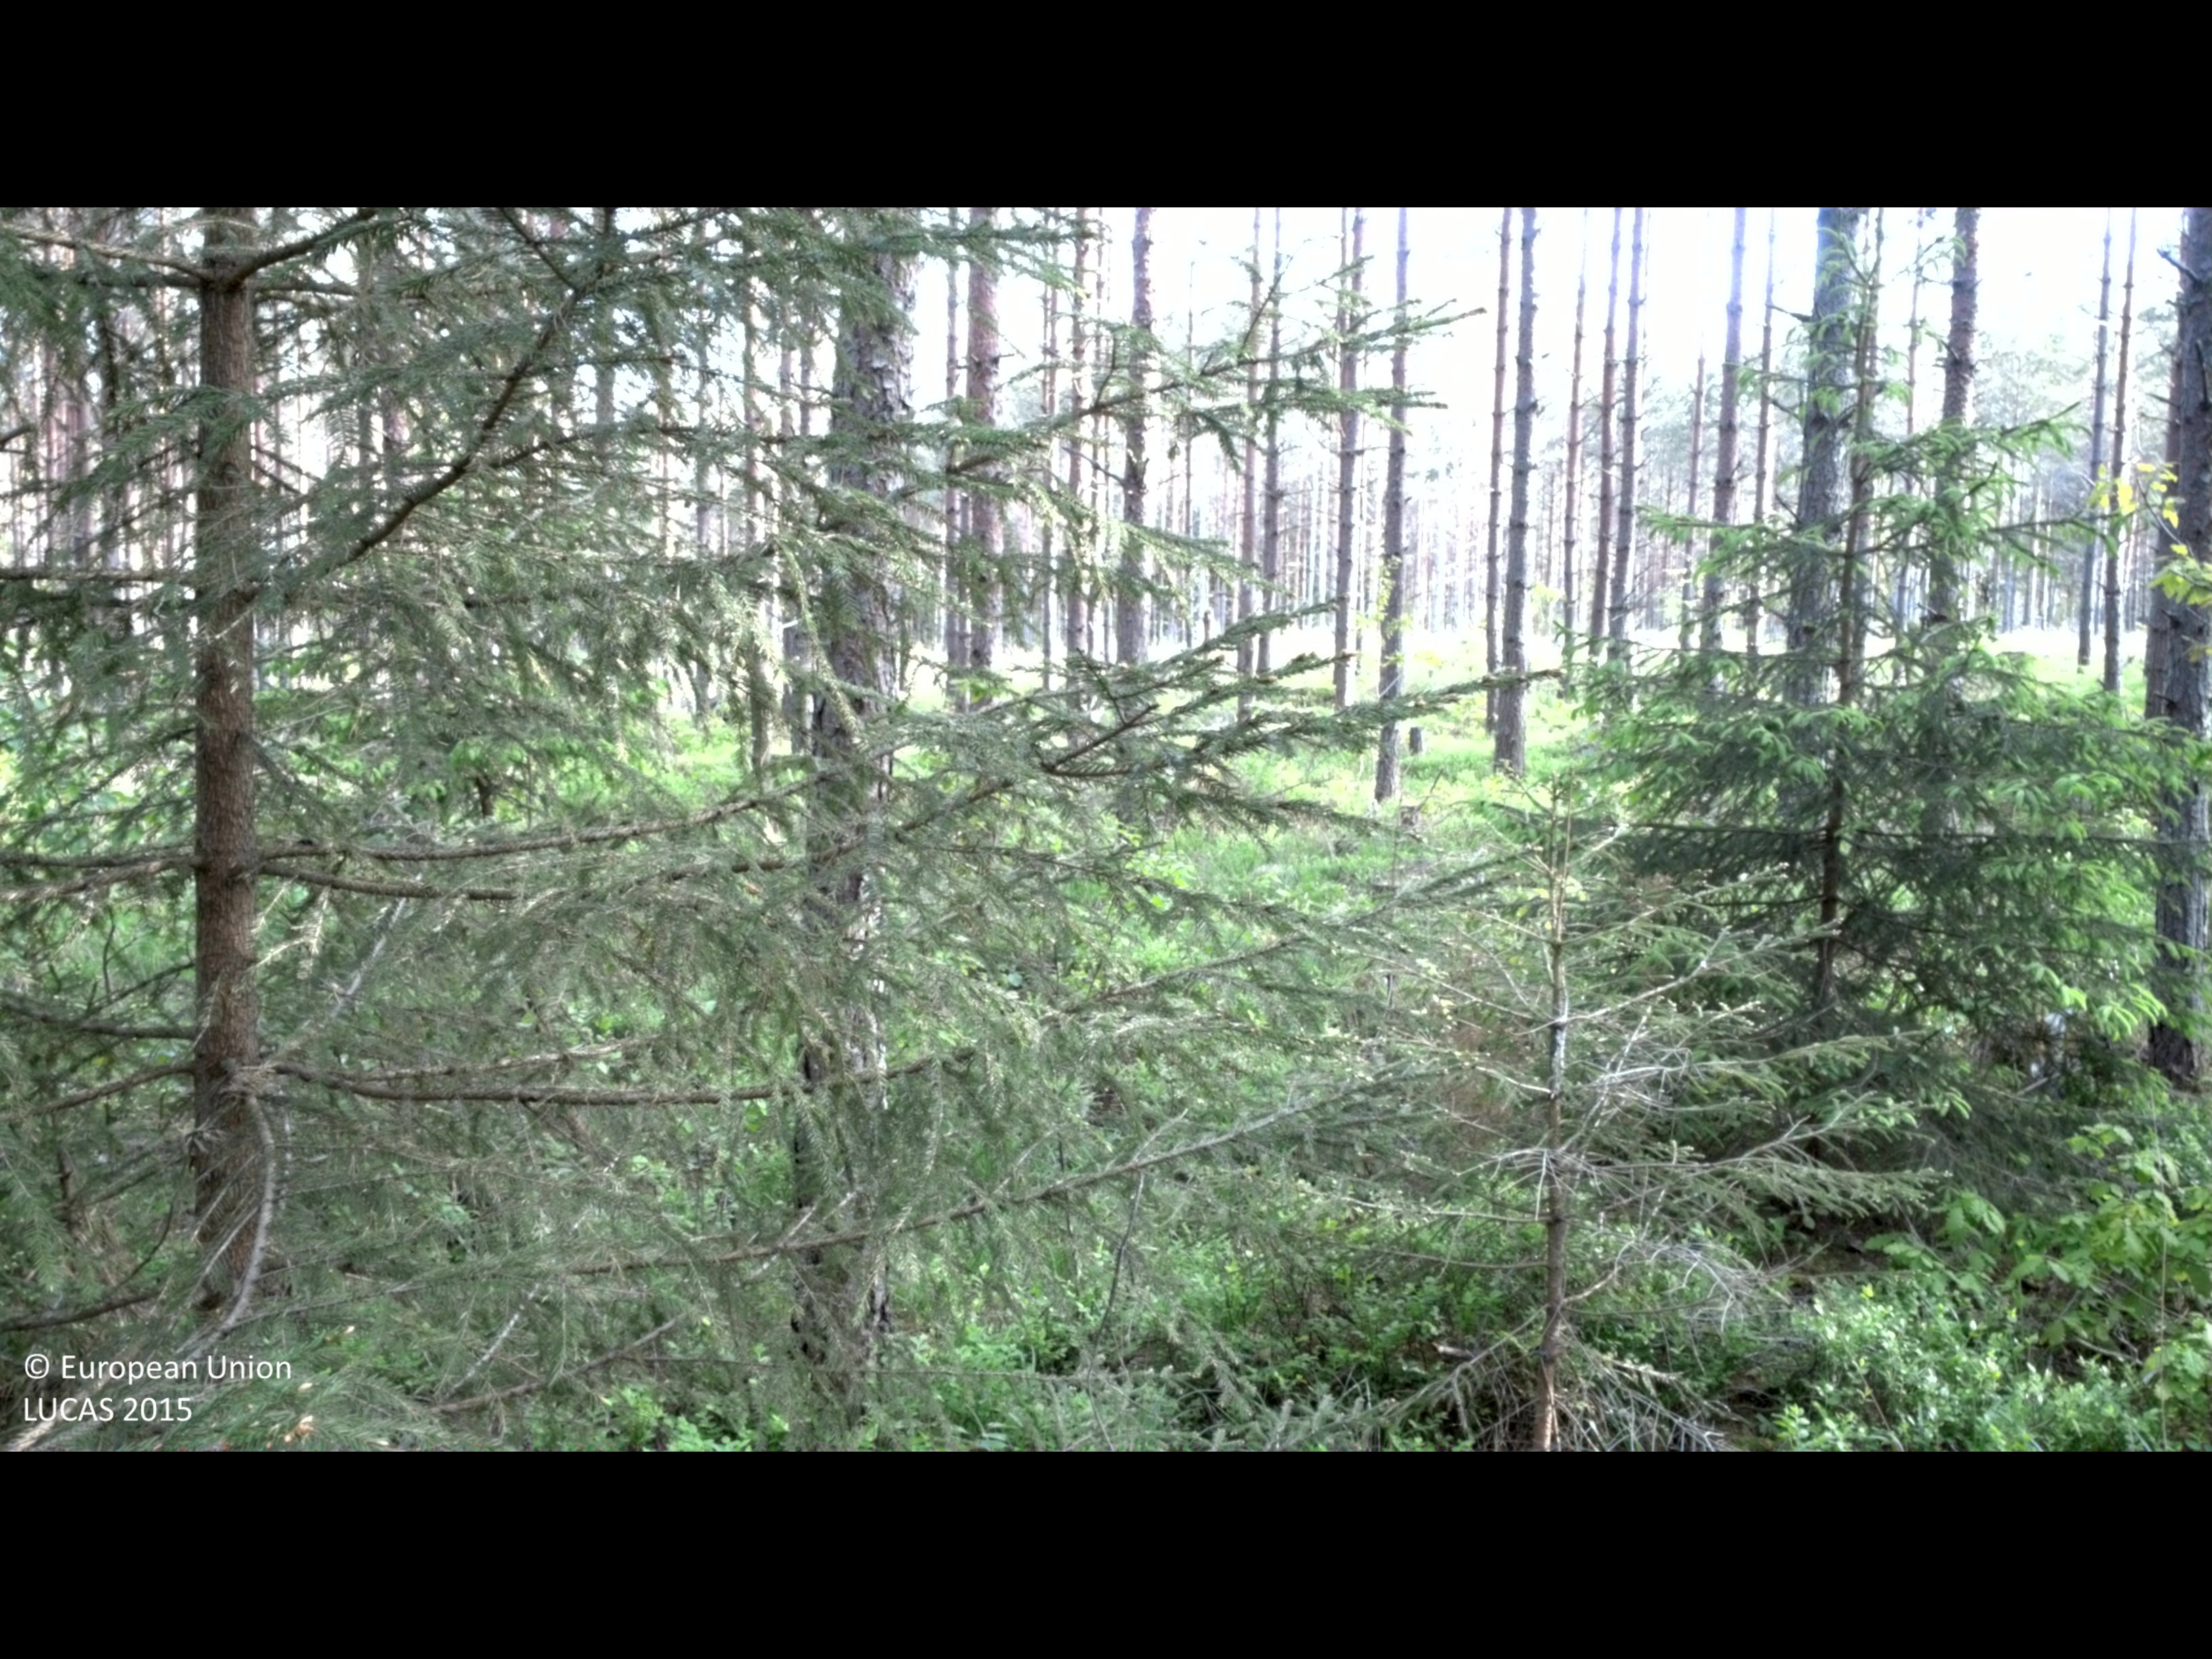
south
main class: Woodland
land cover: Pine dominated coniferous woodland
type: boreal forest
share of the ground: 50 - 75 %
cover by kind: coniferous forest trees 65 %, shrubs 30 %, herbaceous plants 5 %
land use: Forestry
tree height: > 5 m
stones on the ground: 10 - 25 %
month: June
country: SE
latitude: 57.6054
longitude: 16.2405
